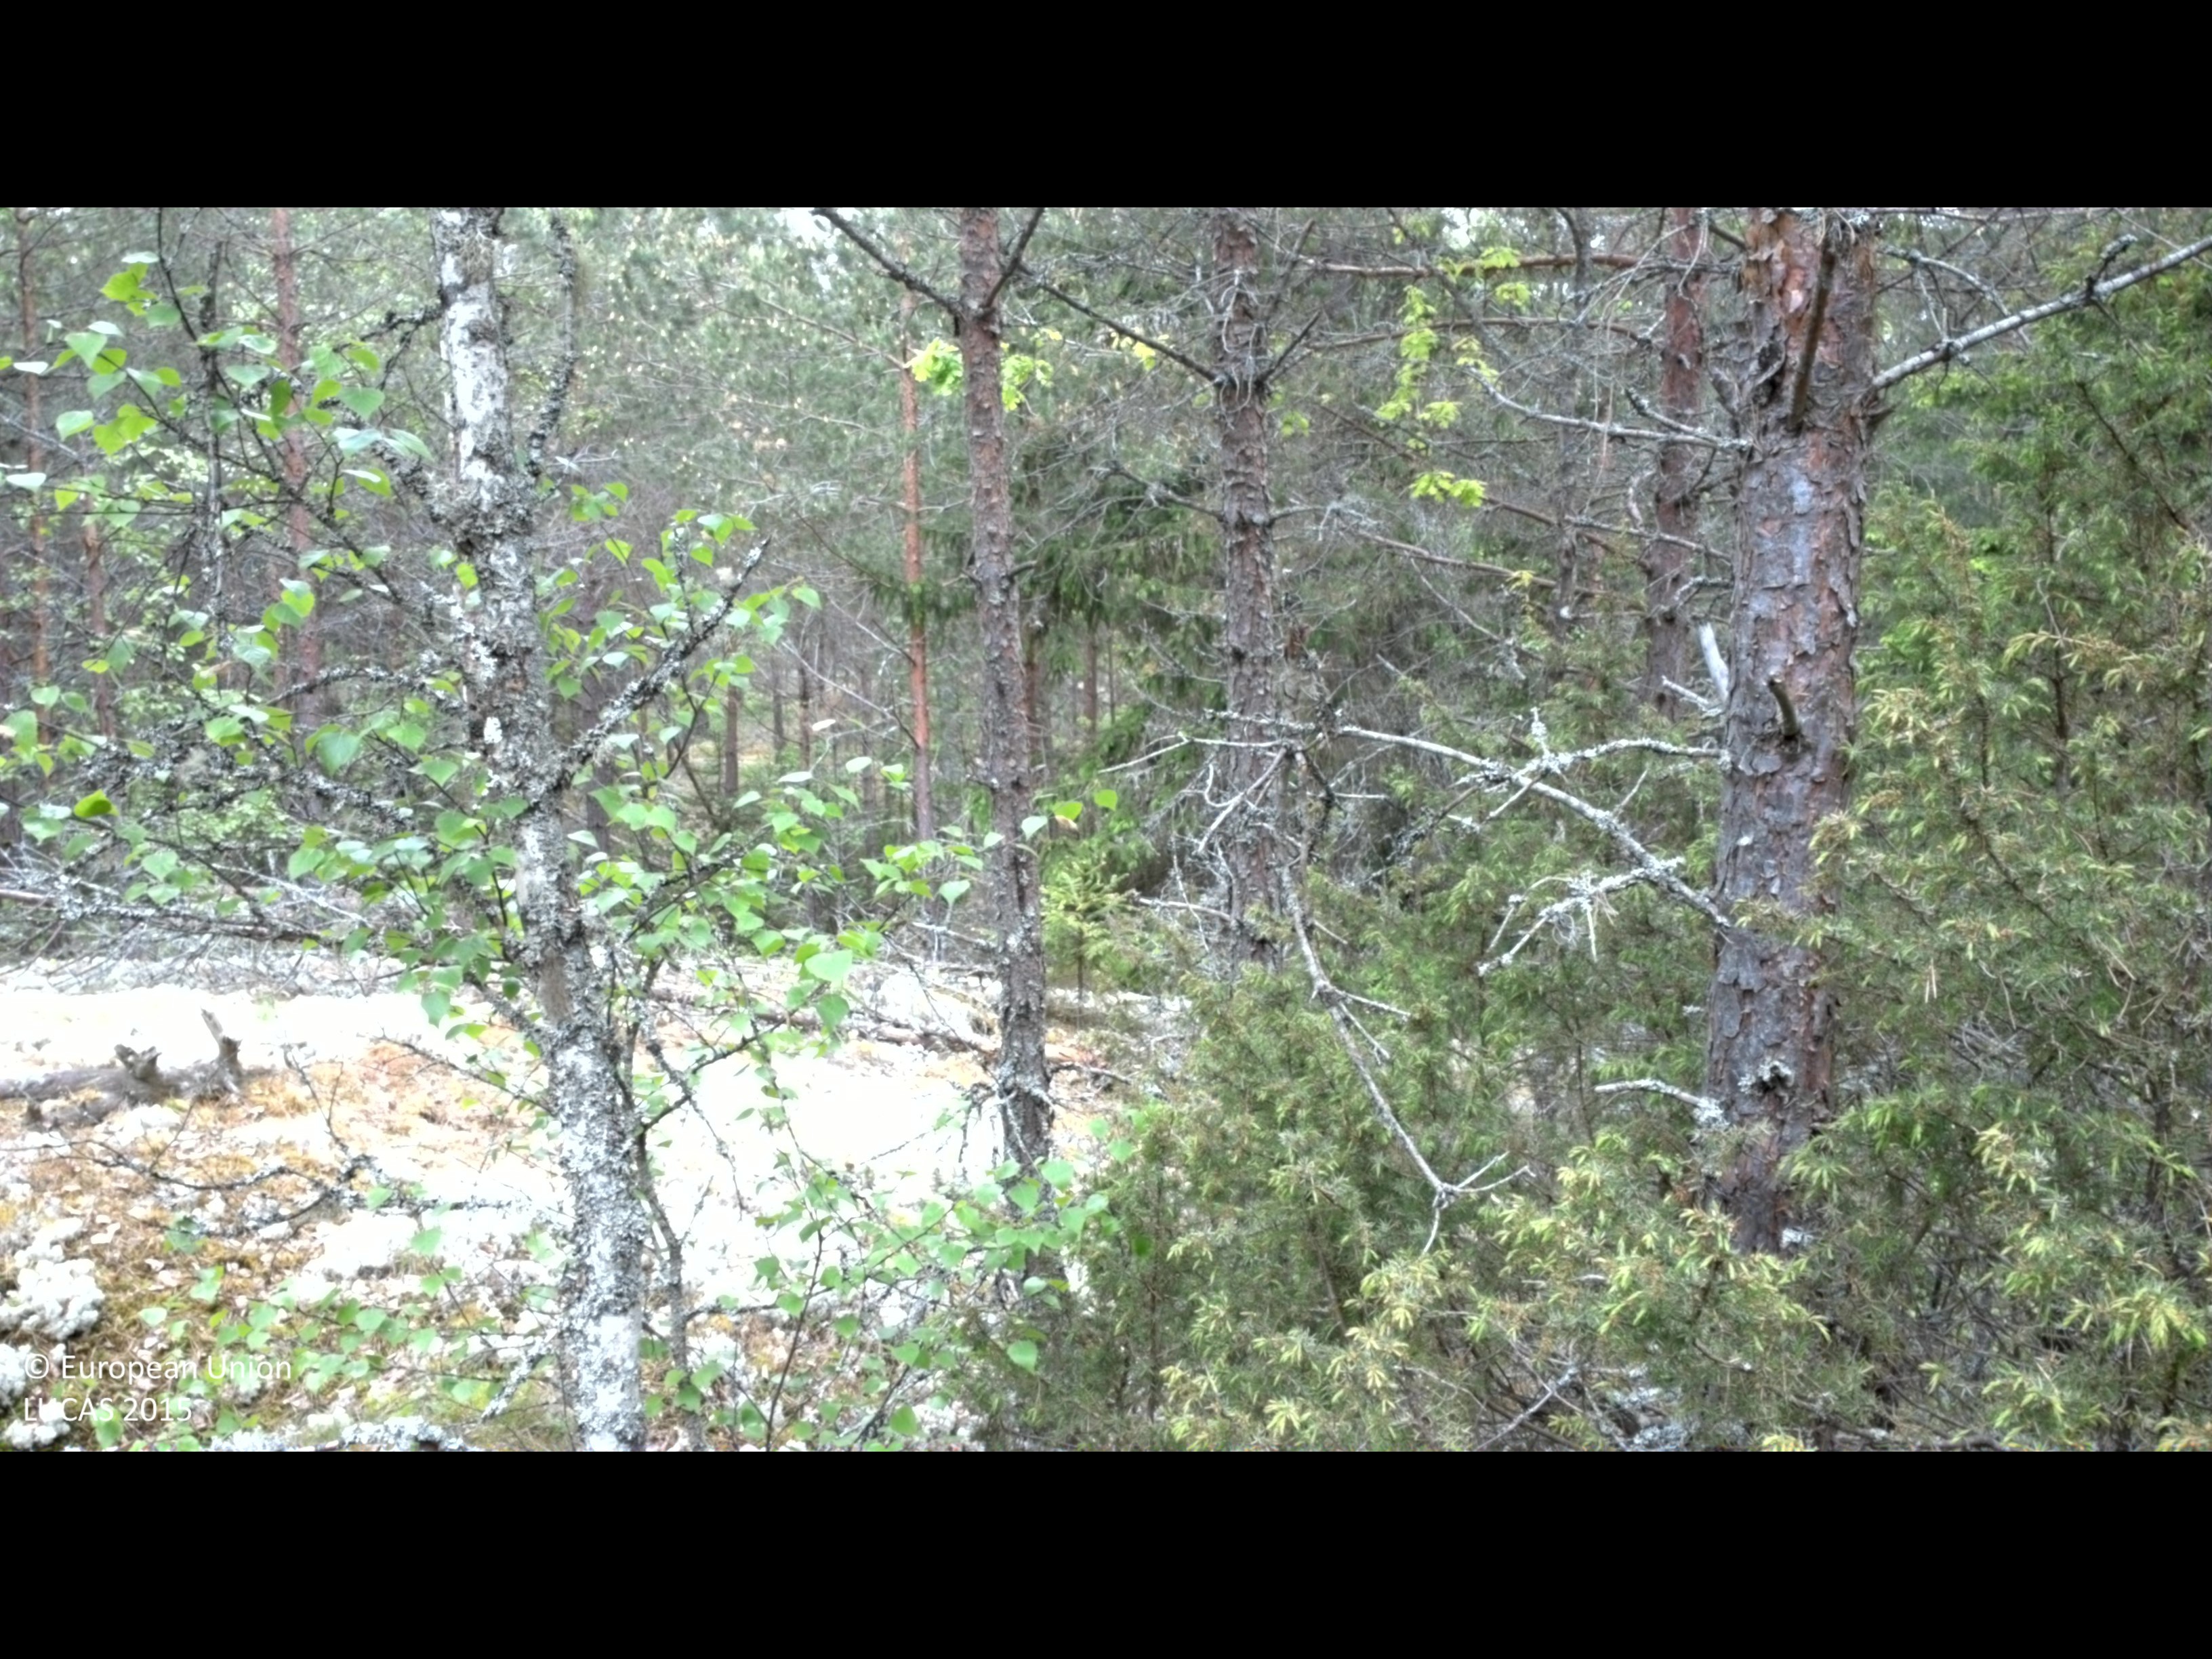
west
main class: Woodland
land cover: Pine dominated coniferous woodland
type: boreal forest
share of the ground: 25 - 50 %
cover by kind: coniferous forest trees 45 %, shrubs 30 %, lichens and mosses 20 %, broadleaved forest trees 5 %
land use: Forestry
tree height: > 5 m
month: June
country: SE
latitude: 57.6770
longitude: 16.2526
